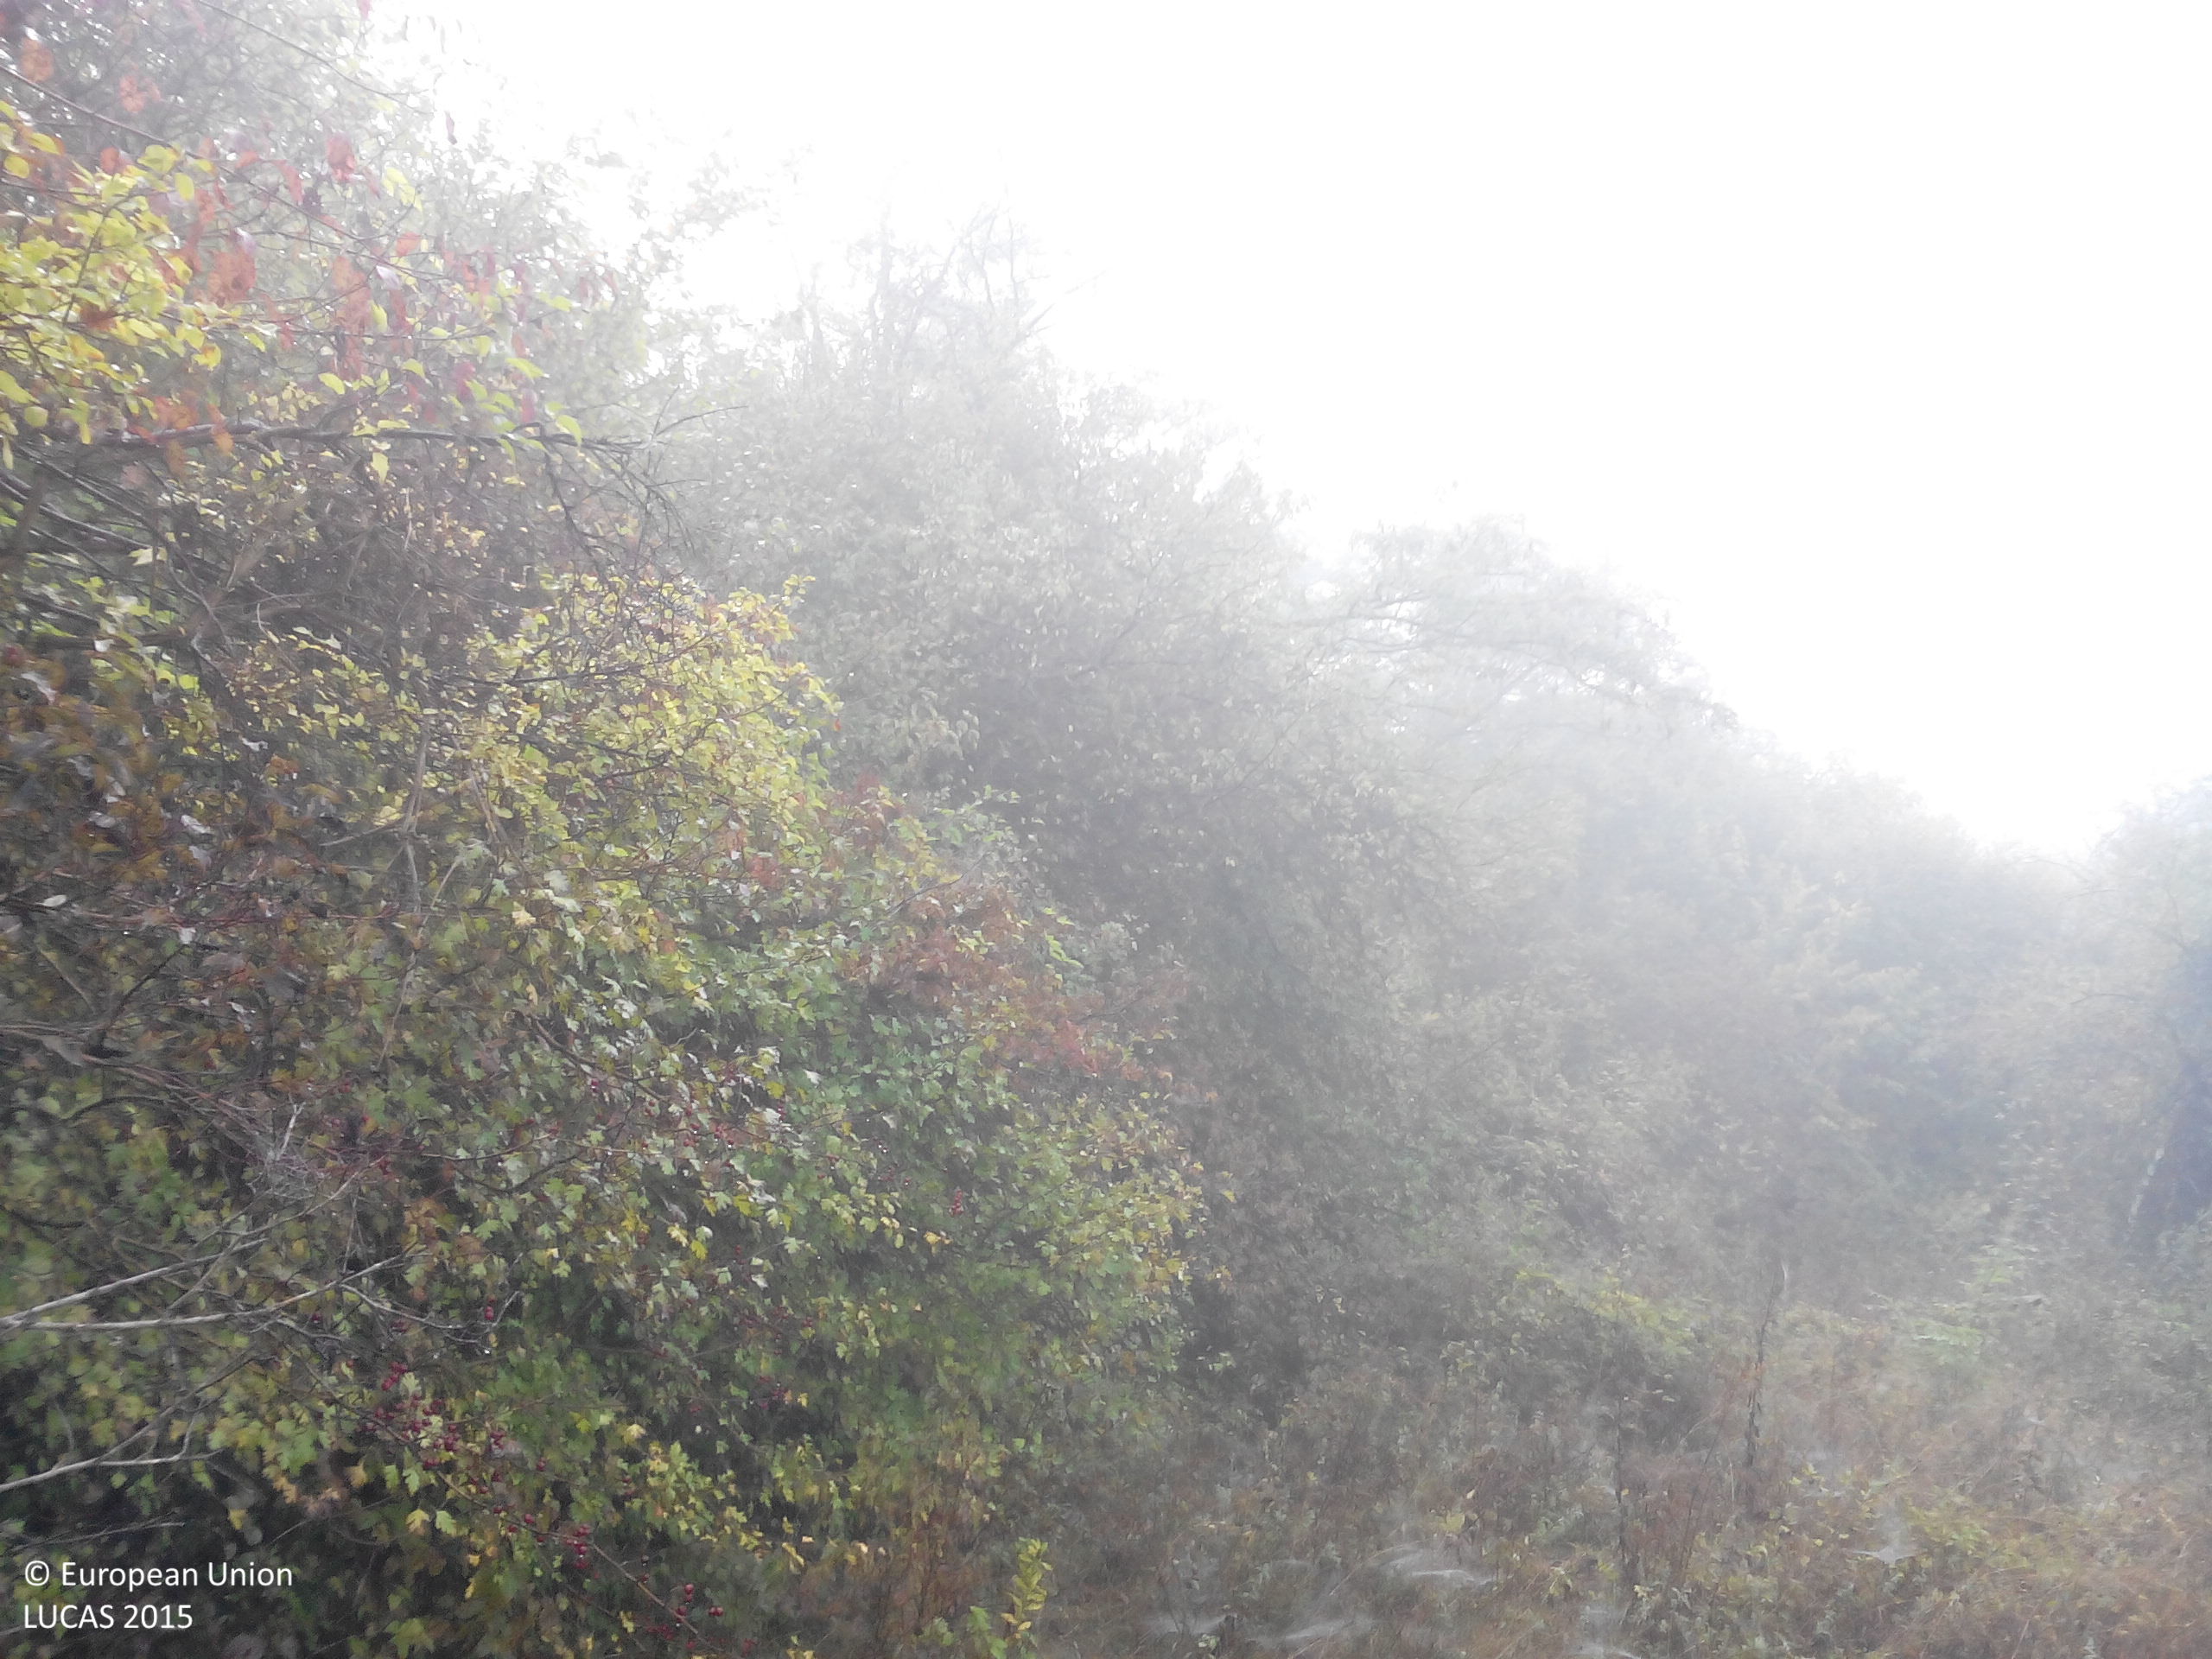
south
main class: Woodland
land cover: Broadleaved woodland
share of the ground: 50 - 75 %
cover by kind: shrubs 50 %, herbaceous plants 30 %, broadleaved forest trees 20 %
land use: Abandoned areas
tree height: > 5 m
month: October
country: BG
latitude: 42.9634
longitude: 24.0860
